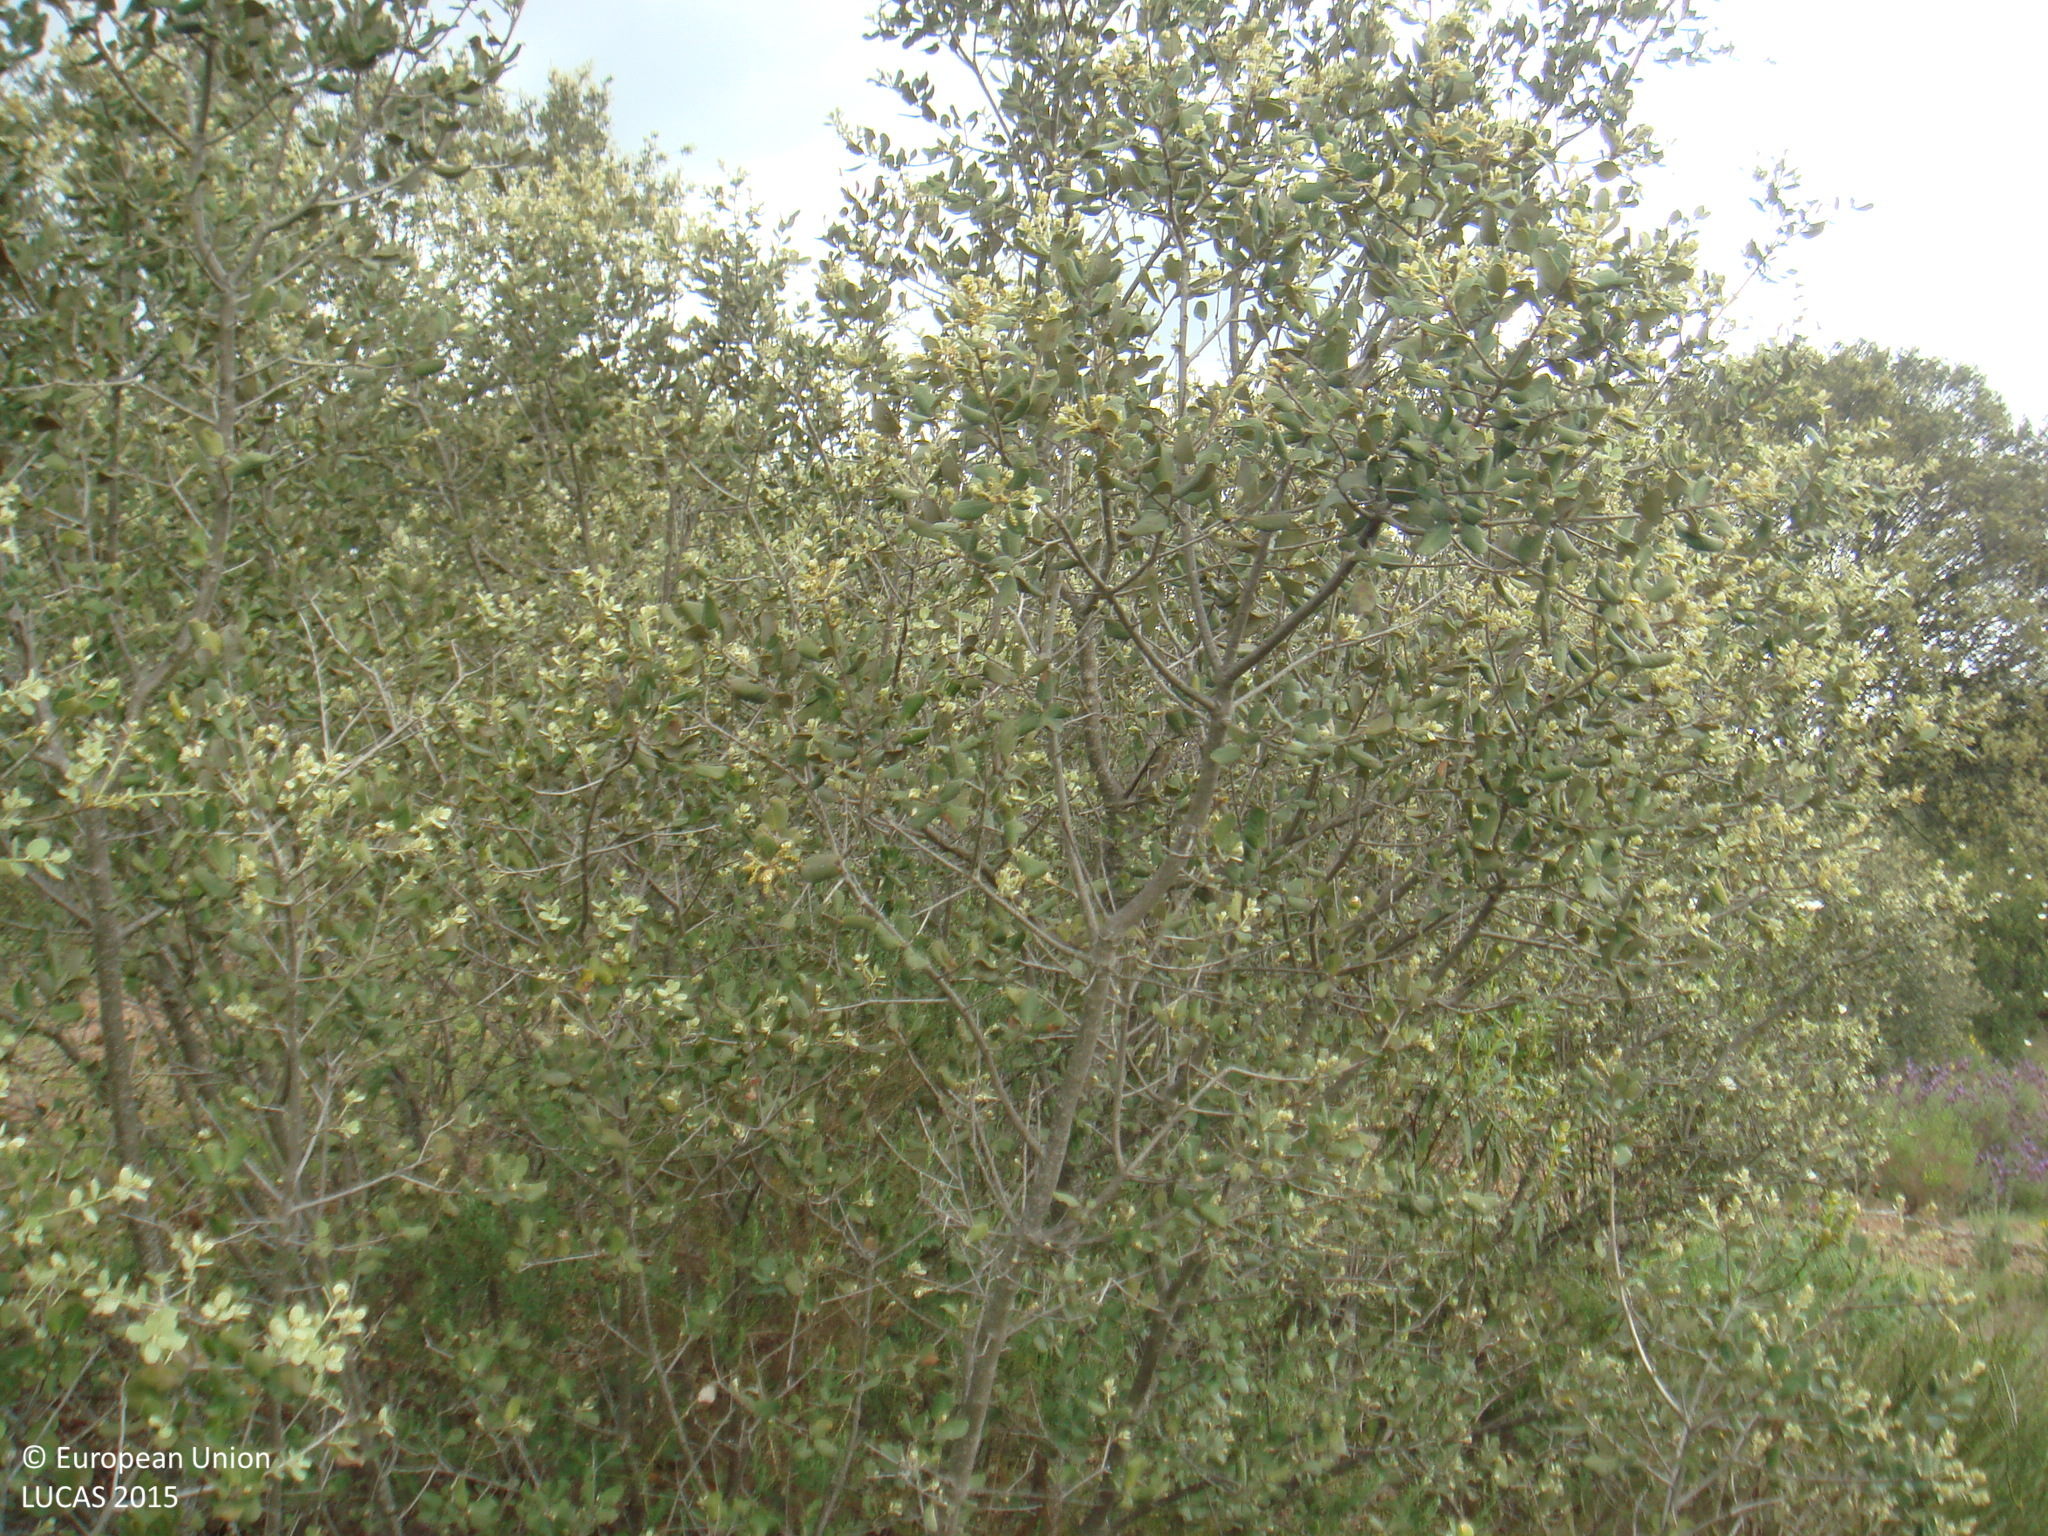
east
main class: Woodland
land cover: Broadleaved woodland
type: broadleaved evergreen forest
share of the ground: 10 - 25 %
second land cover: Shrubland without tree cover
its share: 50 - 75 %
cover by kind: shrubs 65 %, broadleaved forest trees 20 %, unconsolidated bare surface 10 %, herbaceous plants 5 %
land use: Forestry
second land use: Agriculture (excluding fallow land and kitchen gardens)
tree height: < 5 m
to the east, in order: Broadleaved woodland; Shrubland without tree cover; Fences; Tracks; Fences; Broadleaved woodland; Oats
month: April
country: ES
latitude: 38.1610
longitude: -5.0538
